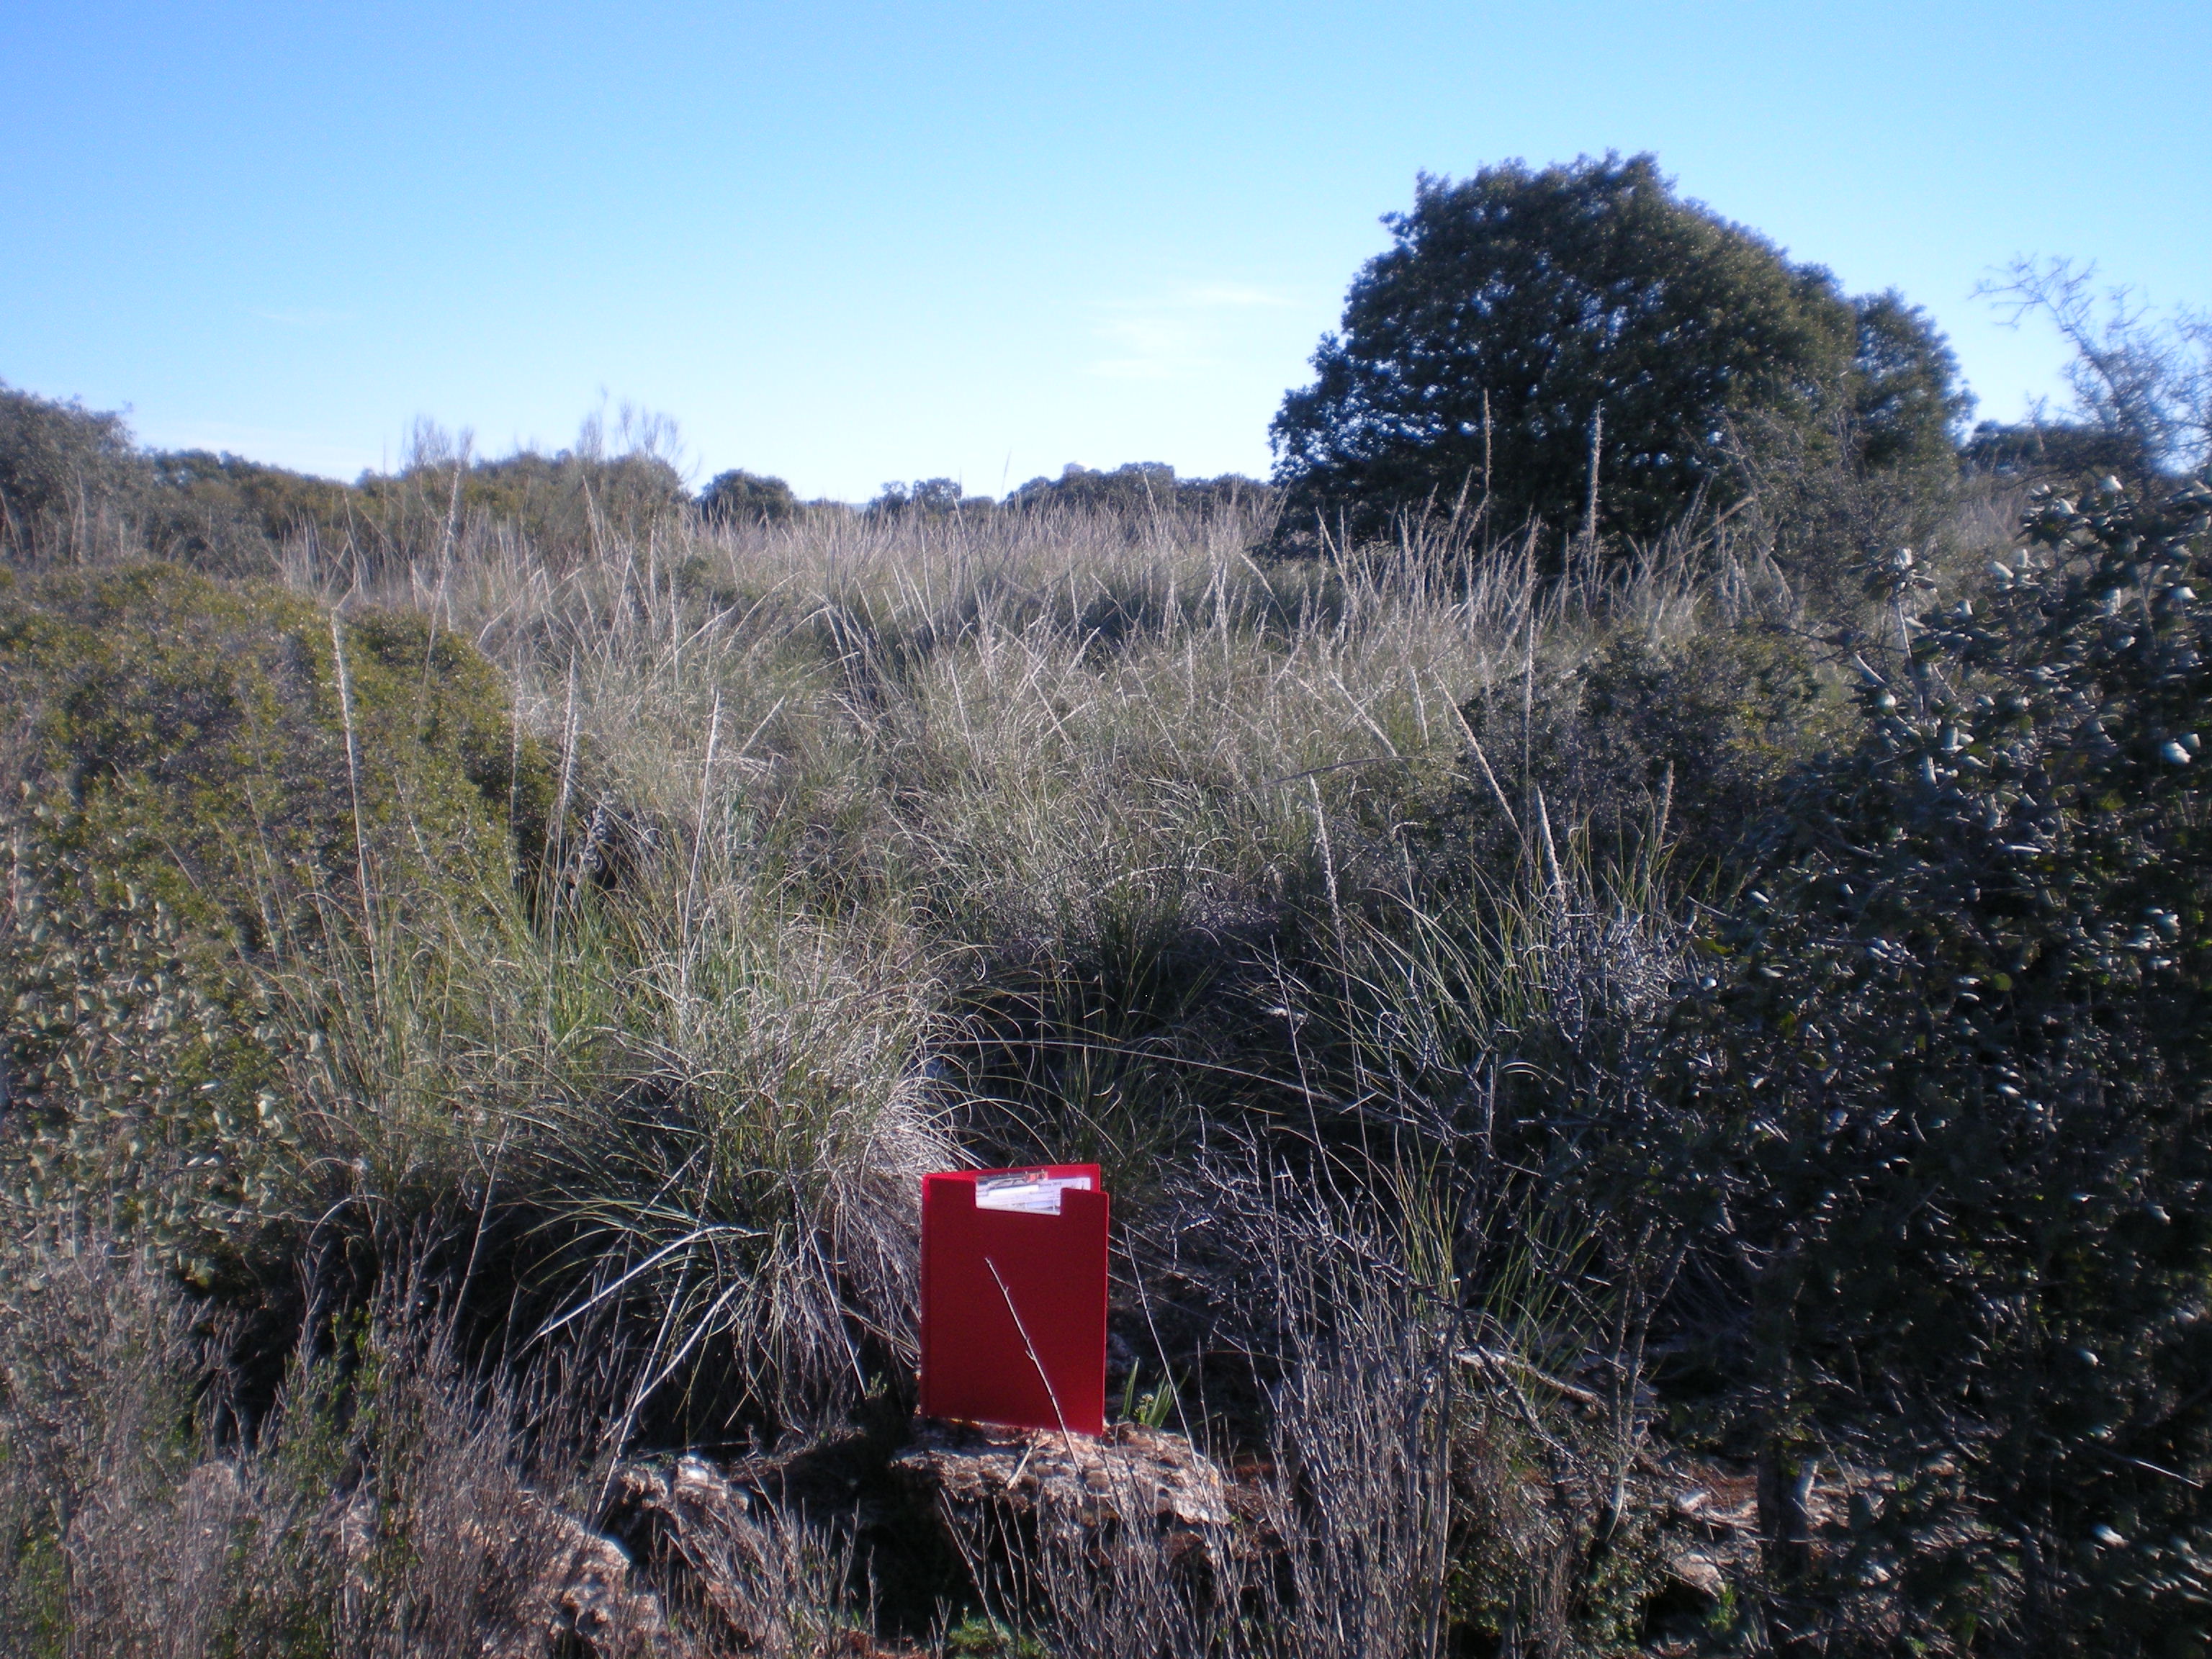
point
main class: Woodland
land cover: Broadleaved woodland
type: broadleaved evergreen forest
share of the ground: 25 - 50 %
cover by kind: shrubs 50 %, broadleaved forest trees 25 %, consolidated bare surface 20 %, herbaceous plants 5 %
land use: Semi-natural and natural areas not in use
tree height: < 5 m
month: April
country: ES
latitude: 38.8290
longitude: -3.0131
